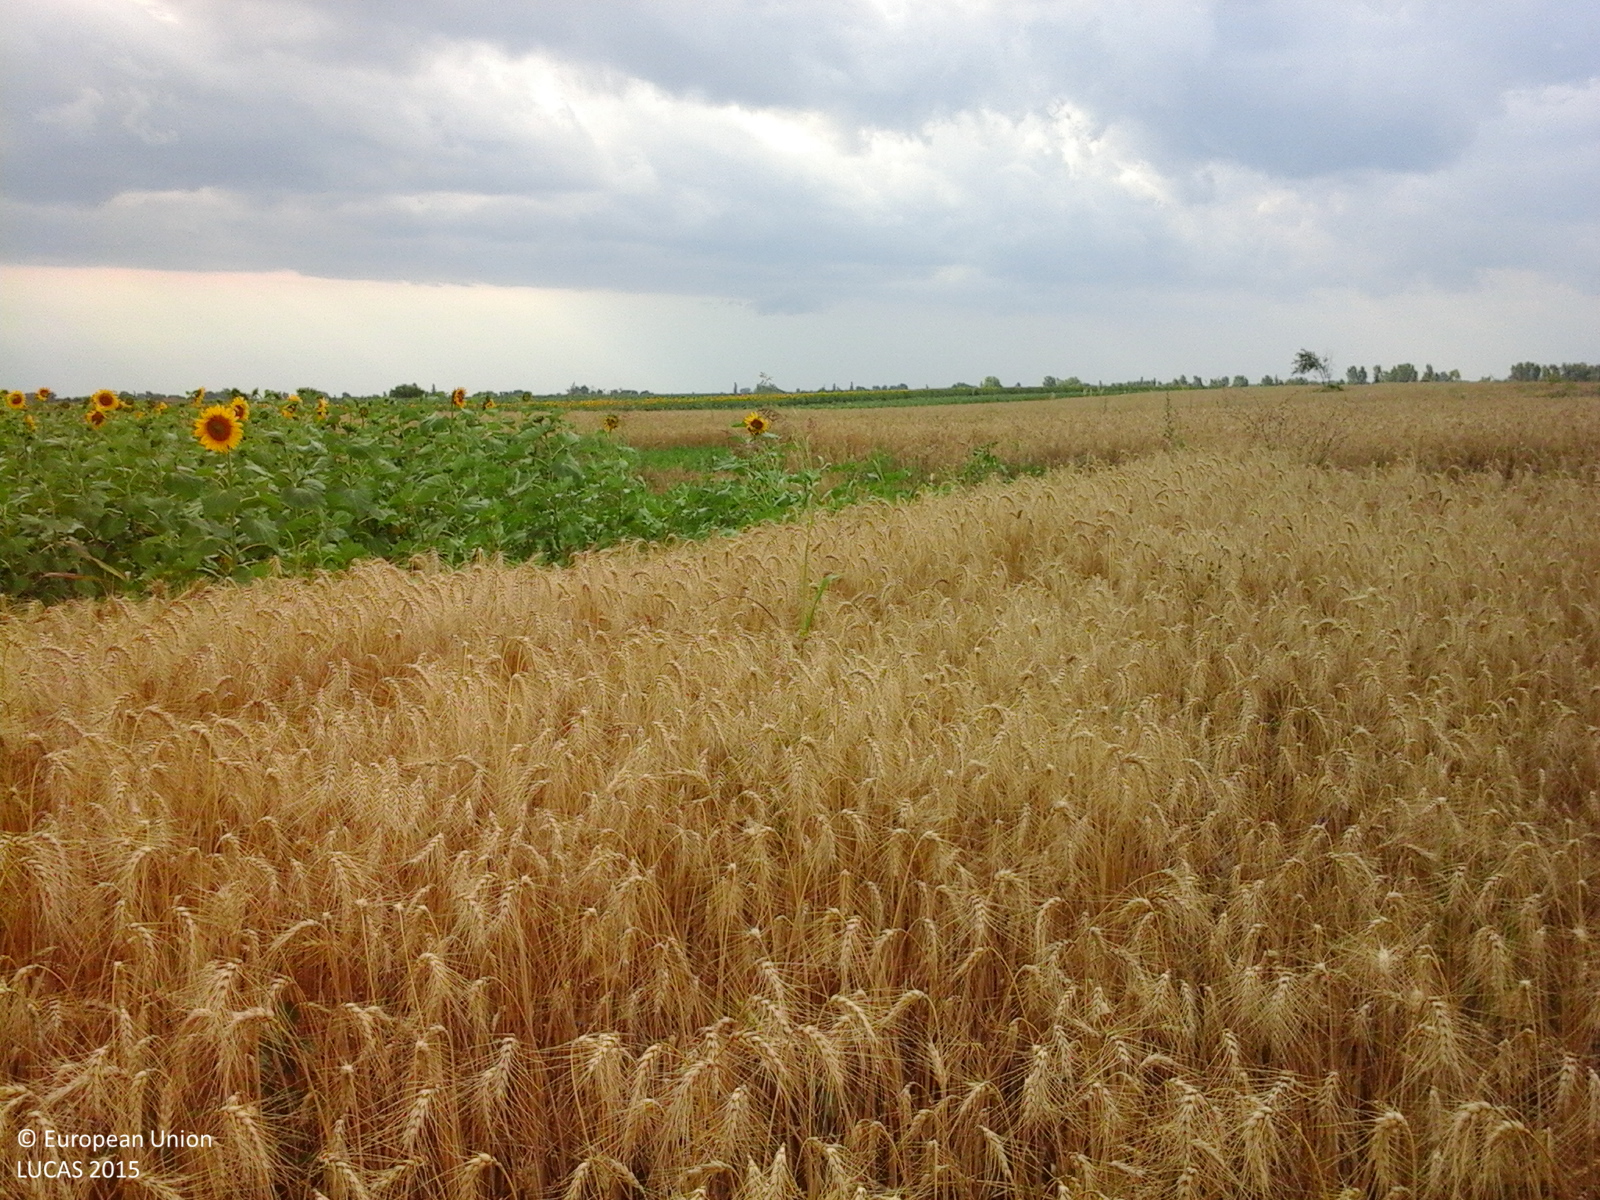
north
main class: Cropland
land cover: Common wheat
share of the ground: > 75 %
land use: Agriculture (excluding fallow land and kitchen gardens)
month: July
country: RO
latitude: 43.9557
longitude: 24.0523
